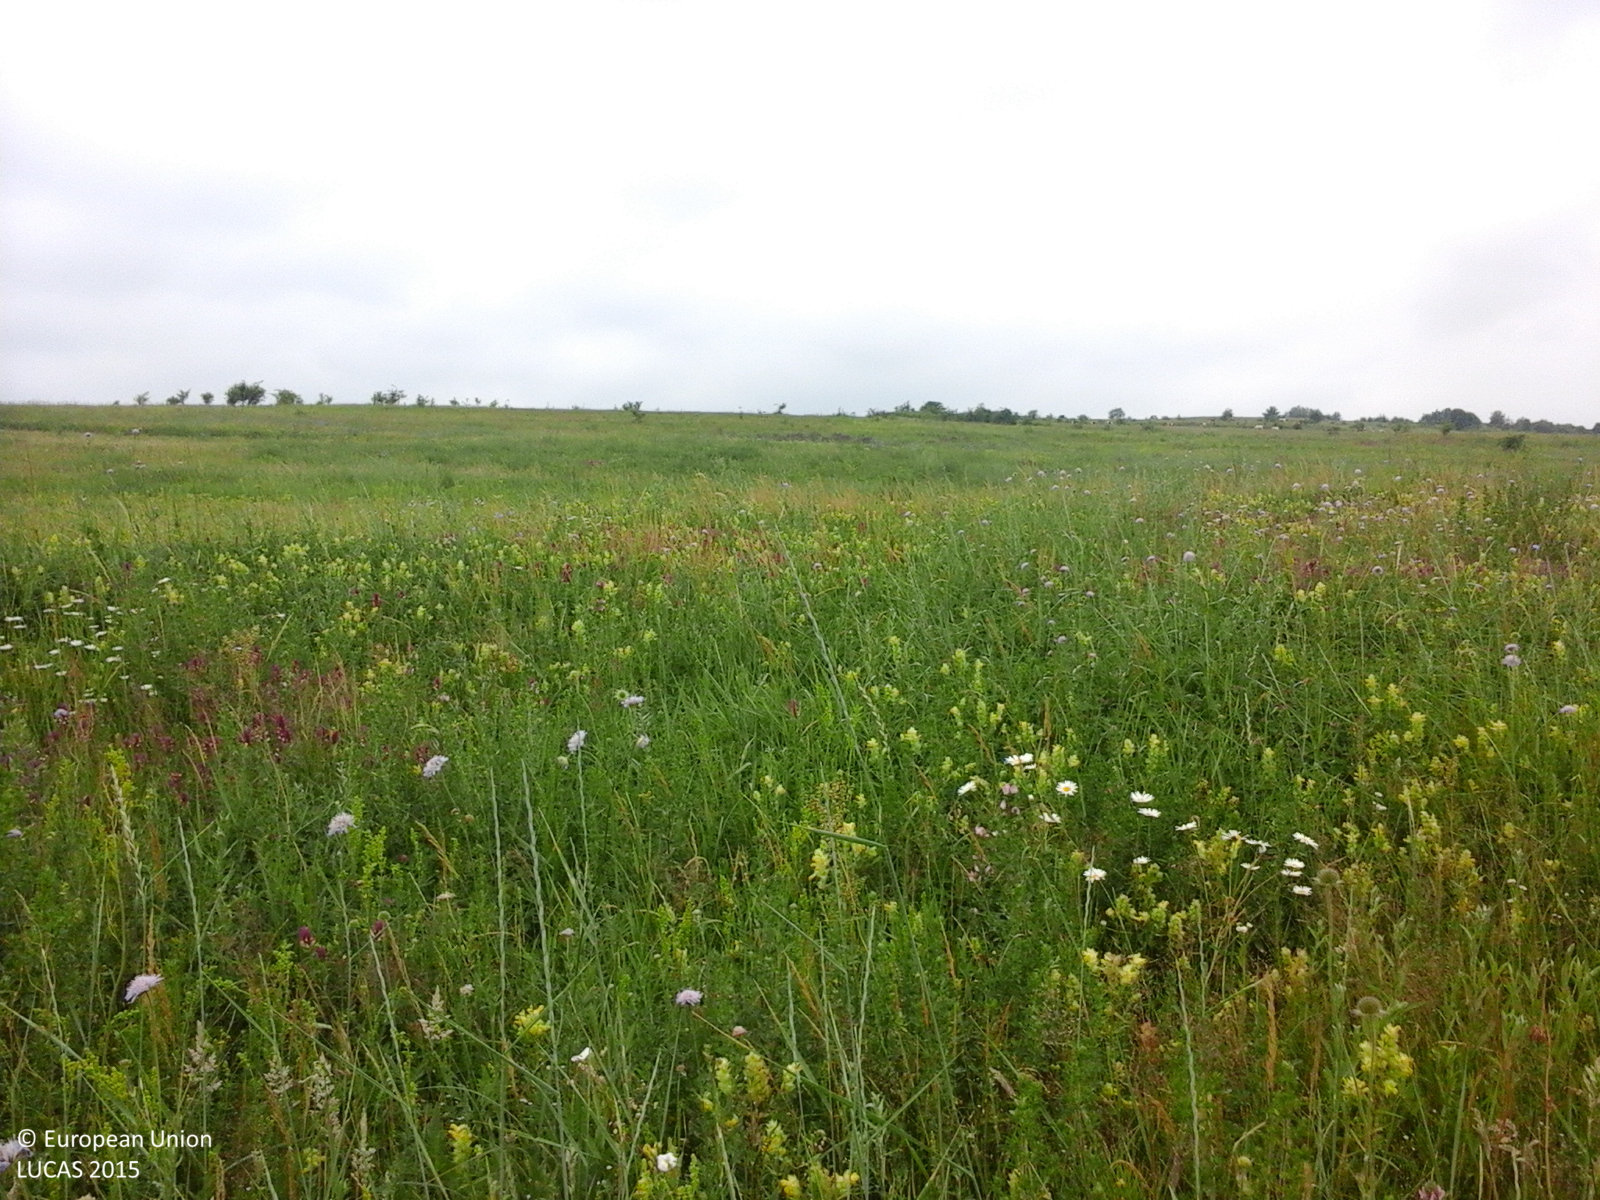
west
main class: Grassland
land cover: Grassland without tree/shrub cover
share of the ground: > 75 %
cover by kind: herbaceous plants 100 %
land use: Agriculture (excluding fallow land and kitchen gardens)
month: June
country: RO
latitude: 47.5641
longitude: 26.4496
